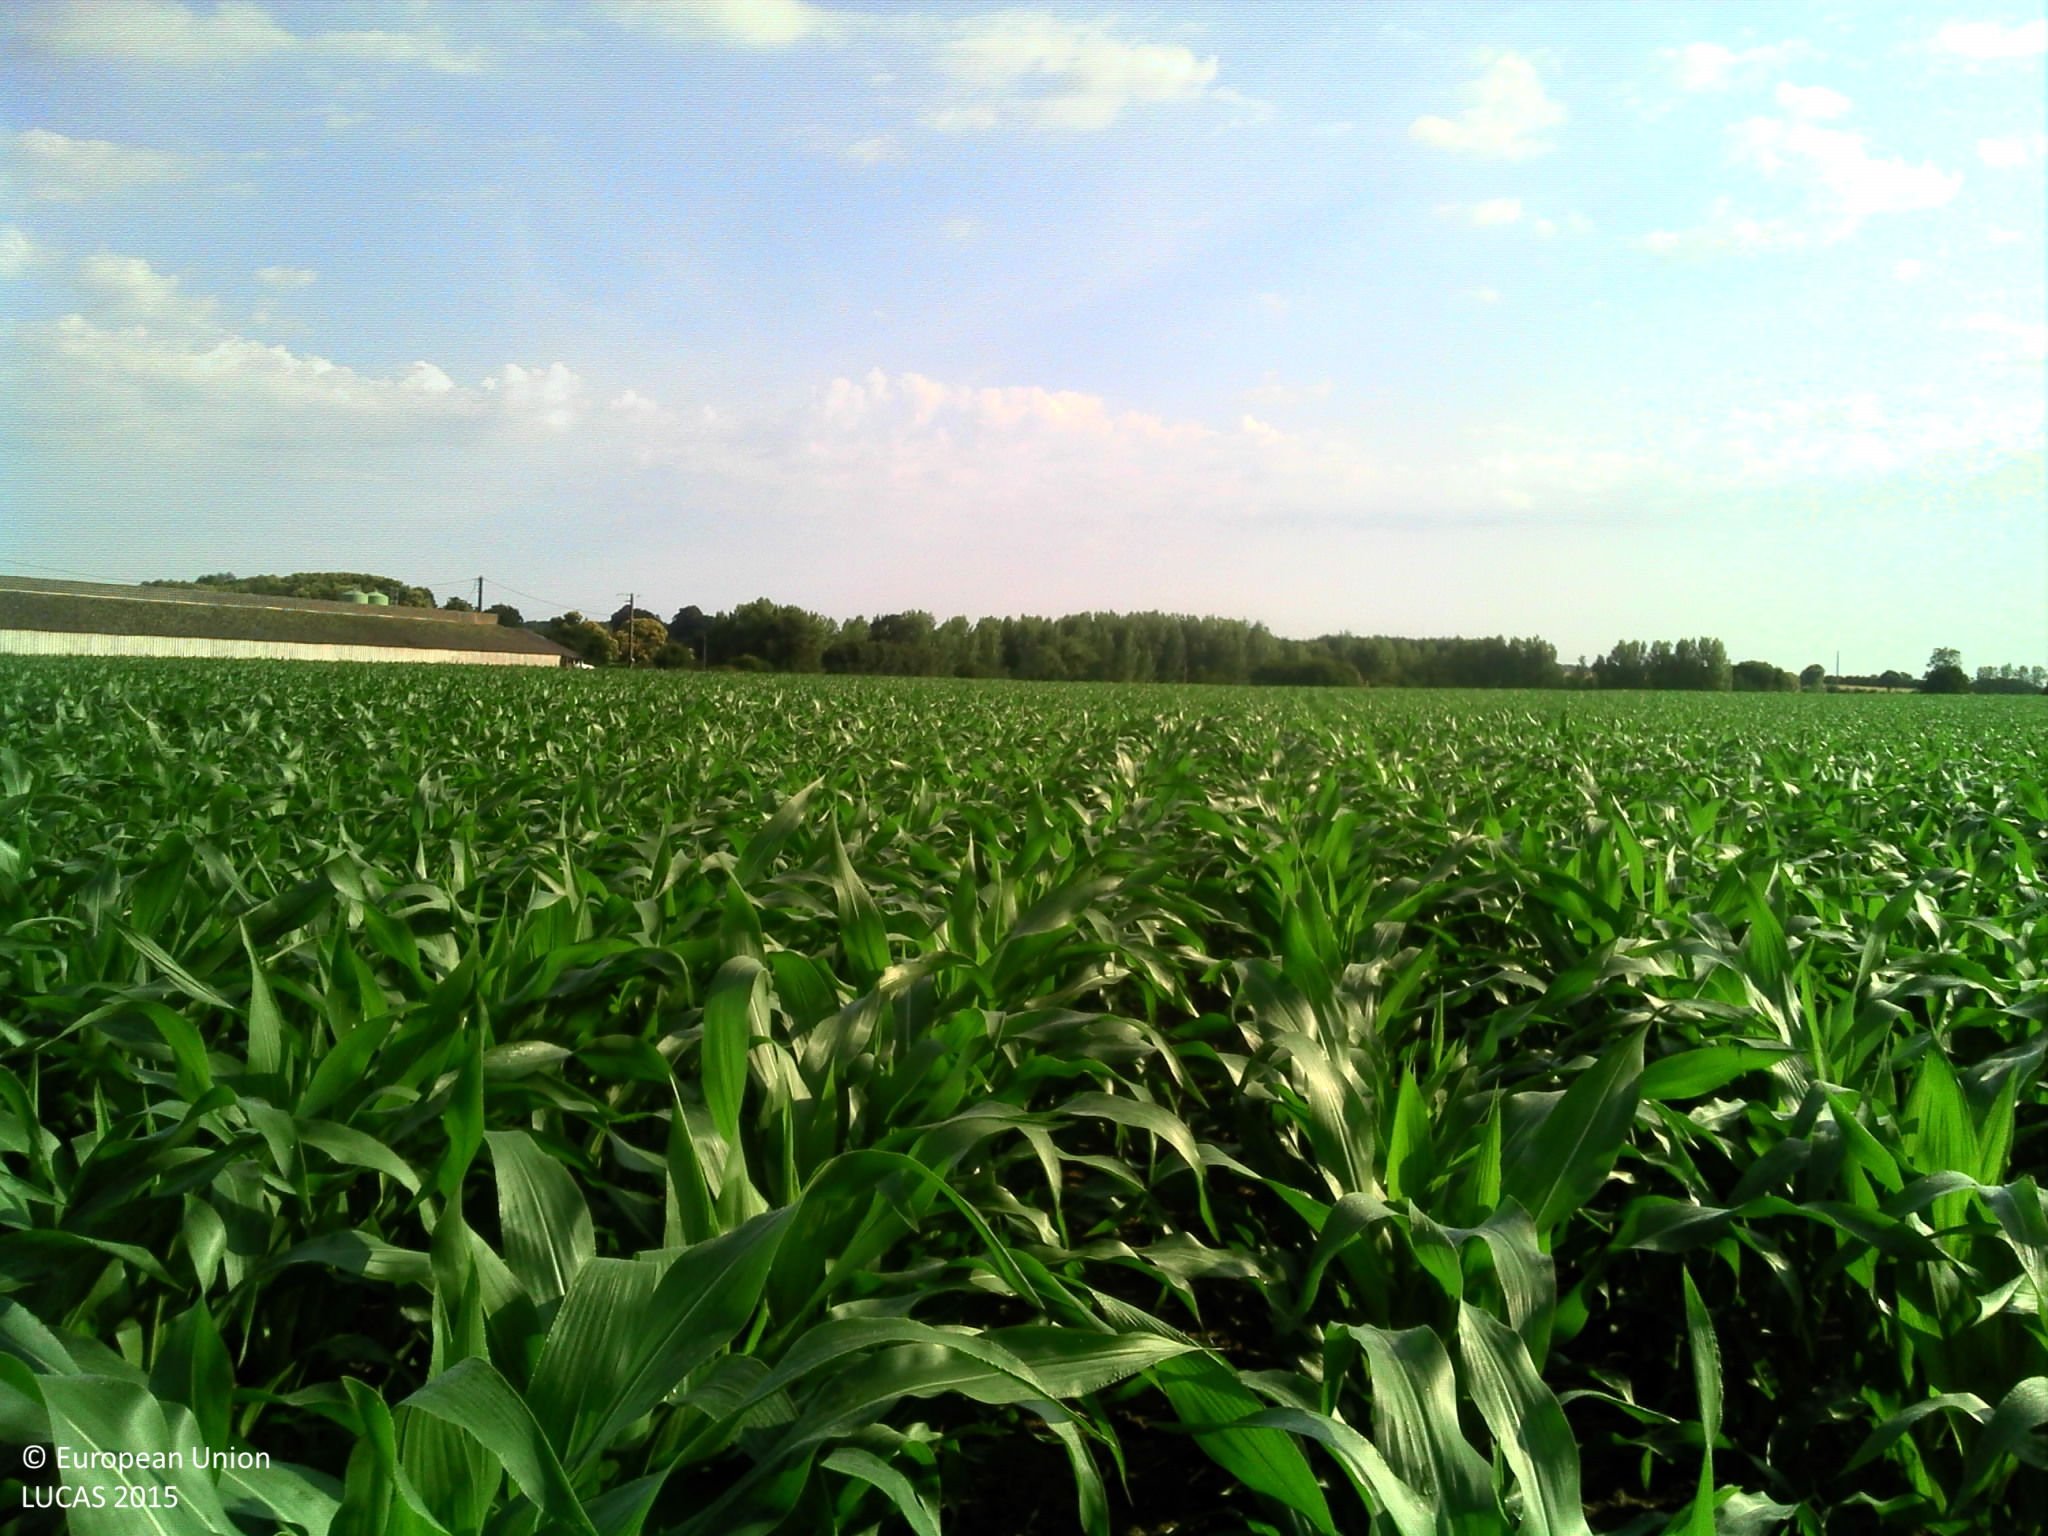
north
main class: Cropland
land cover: Maize
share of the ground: > 75 %
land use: Agriculture (excluding fallow land and kitchen gardens)
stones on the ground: < 10 %
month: July
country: FR
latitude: 48.4144
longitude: -1.5452
